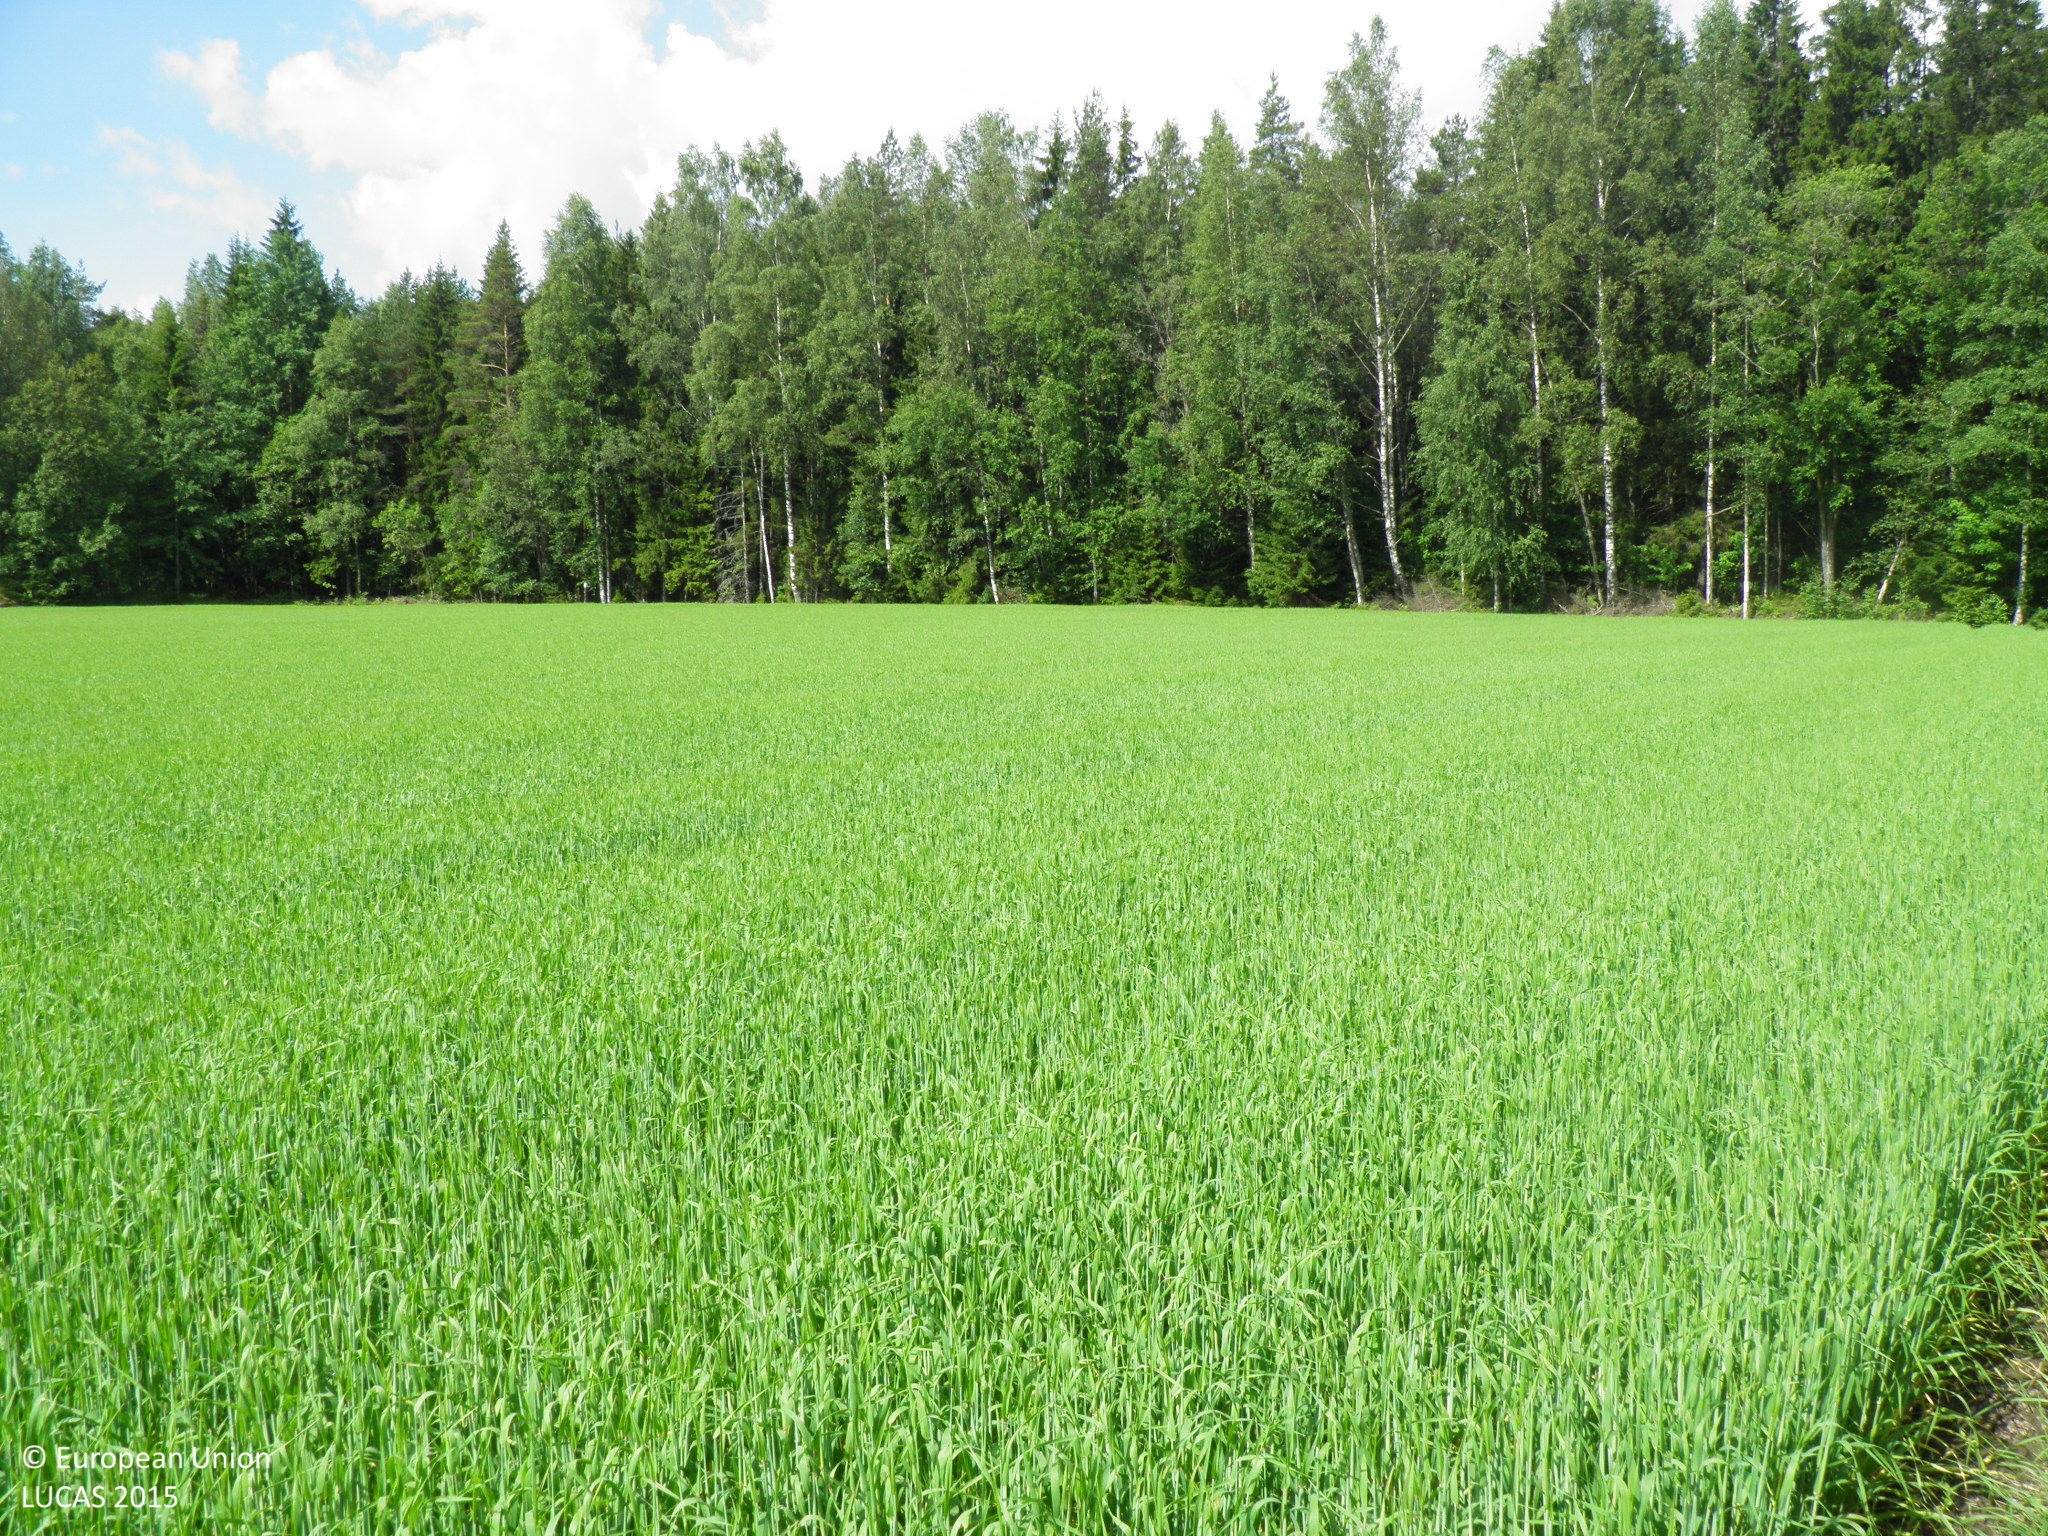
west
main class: Cropland
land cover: Barley
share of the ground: > 75 %
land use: Agriculture (excluding fallow land and kitchen gardens)
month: July
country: FI
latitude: 60.7292
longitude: 22.3696
